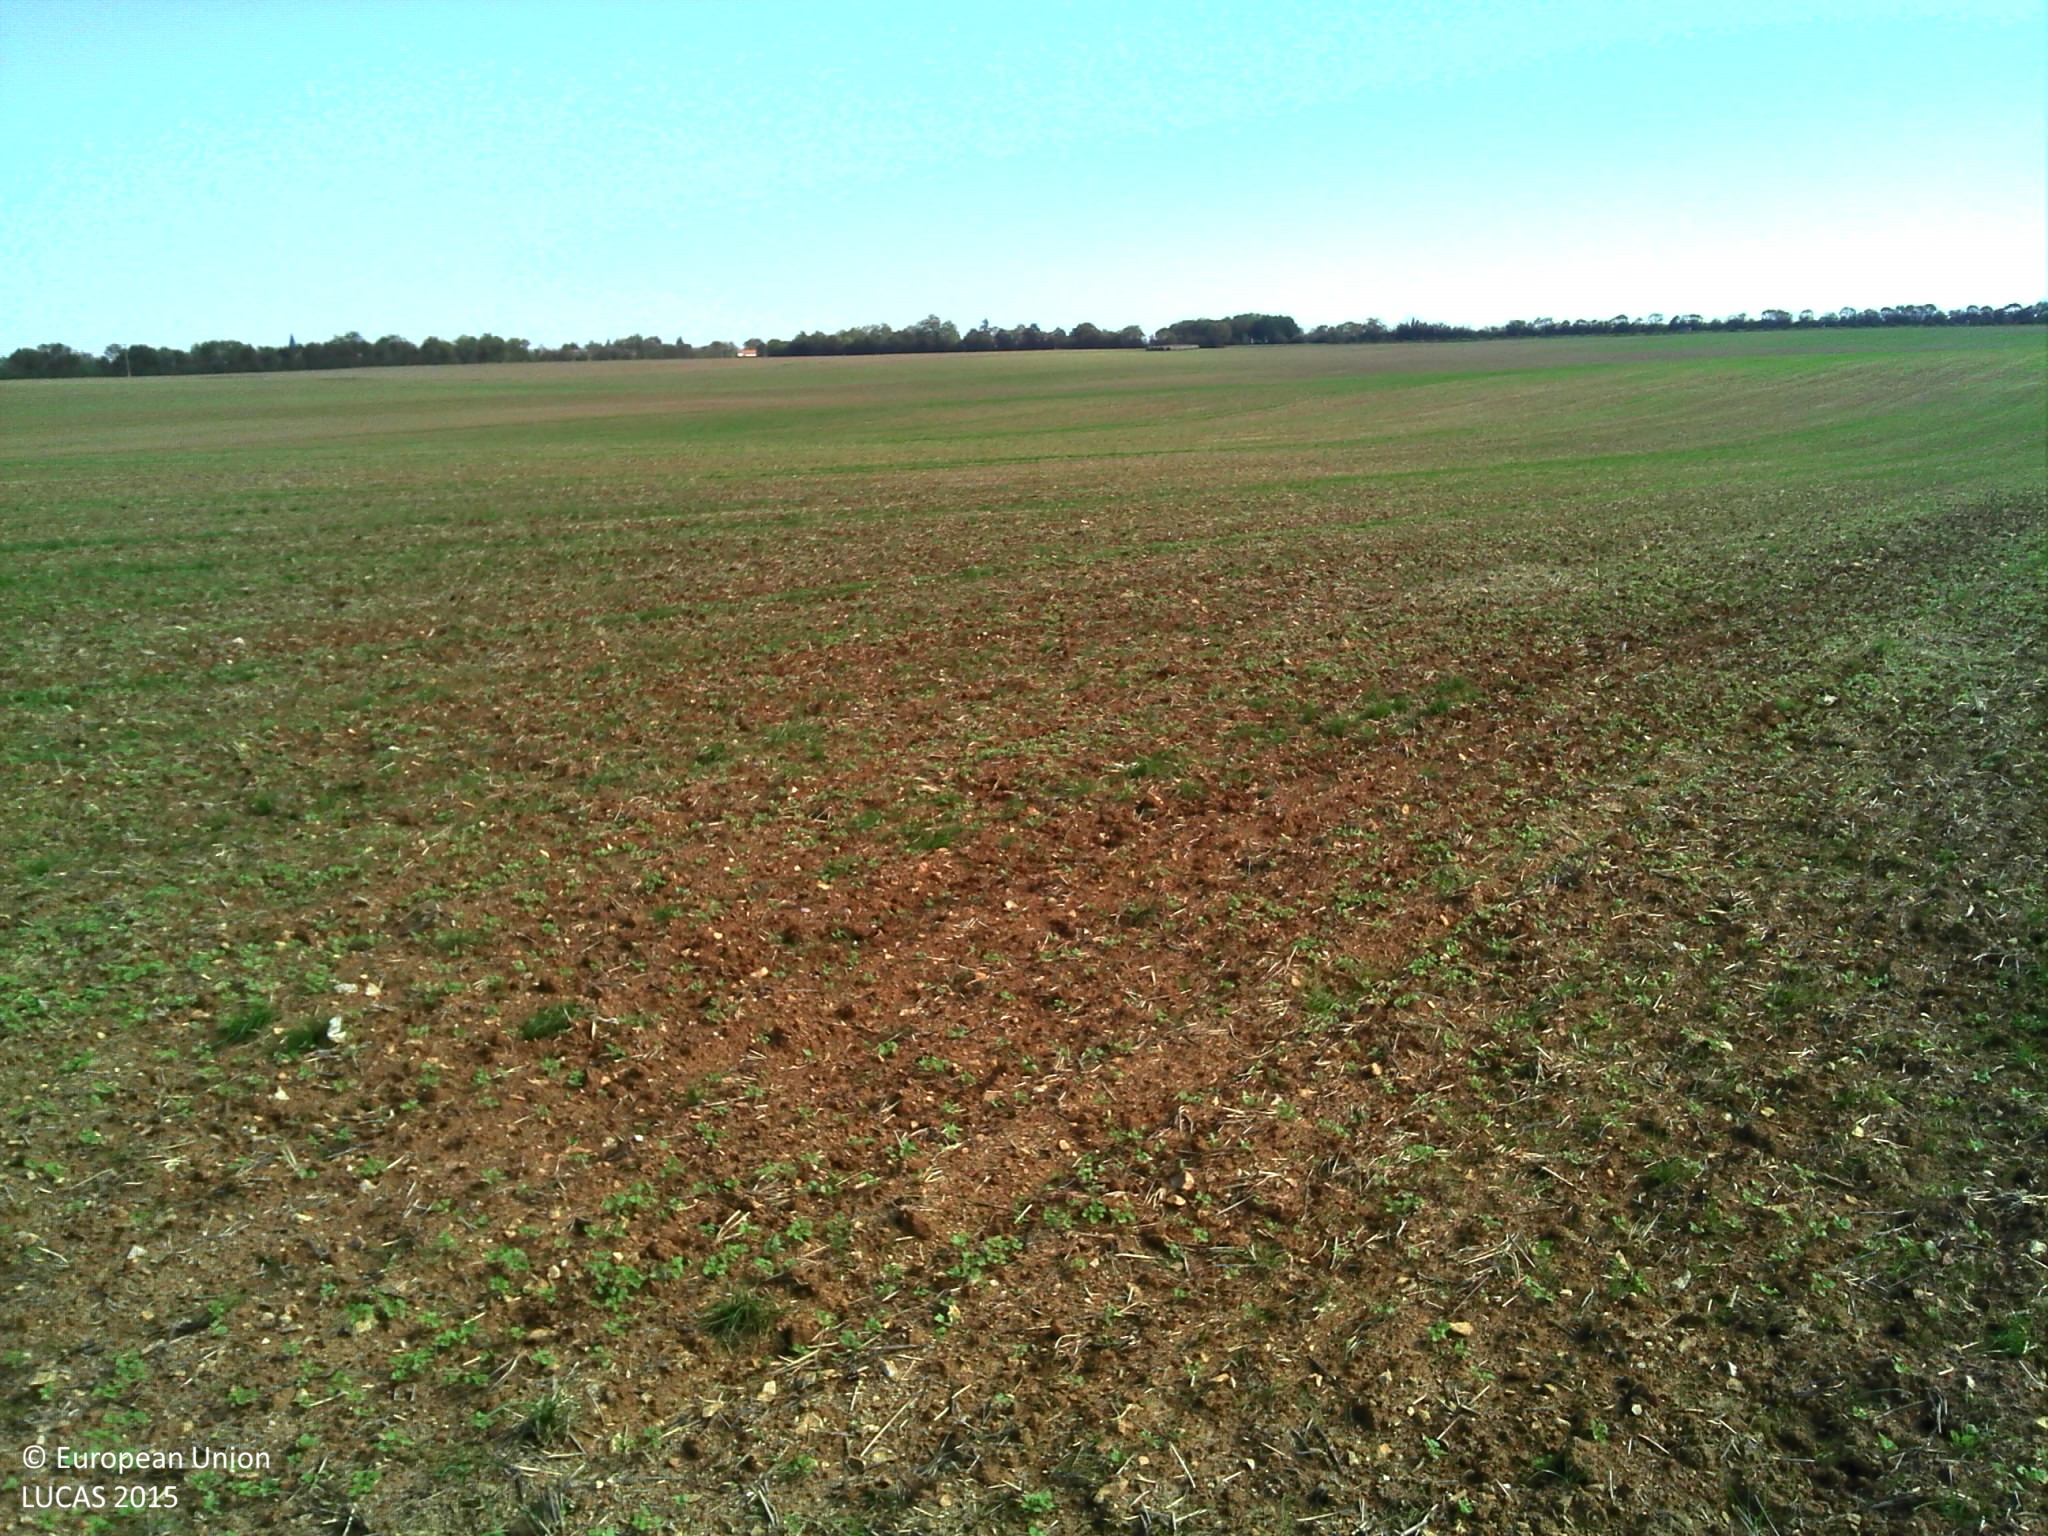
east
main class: Cropland
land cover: Other fibre and oleaginous crops
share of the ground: < 10 %
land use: Agriculture (excluding fallow land and kitchen gardens)
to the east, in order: Other fibre and oleaginous crops
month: September
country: FR
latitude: 46.5167
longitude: -1.0992
